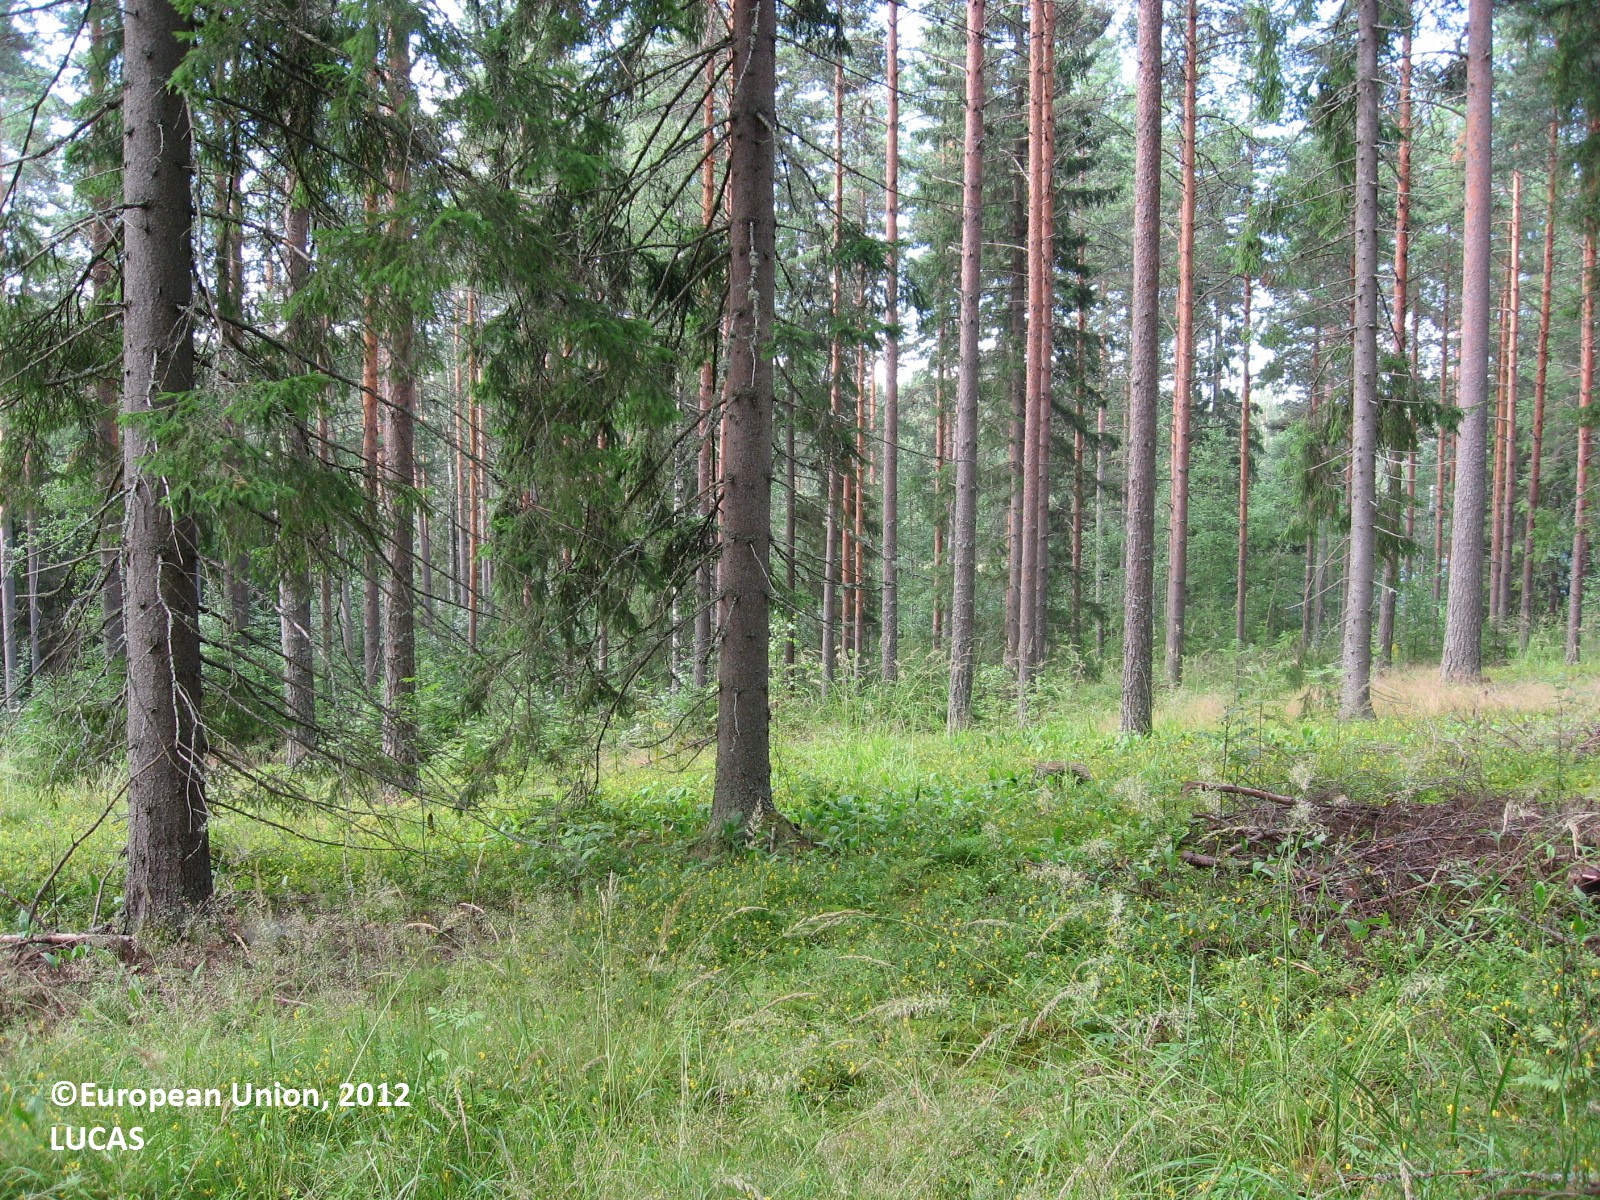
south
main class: Woodland
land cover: Spruce dominated coniferous woodland
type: boreal forest
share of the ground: 25 - 50 %
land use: Forestry
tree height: > 5 m
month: July
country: FI
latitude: 61.2447
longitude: 26.5301
